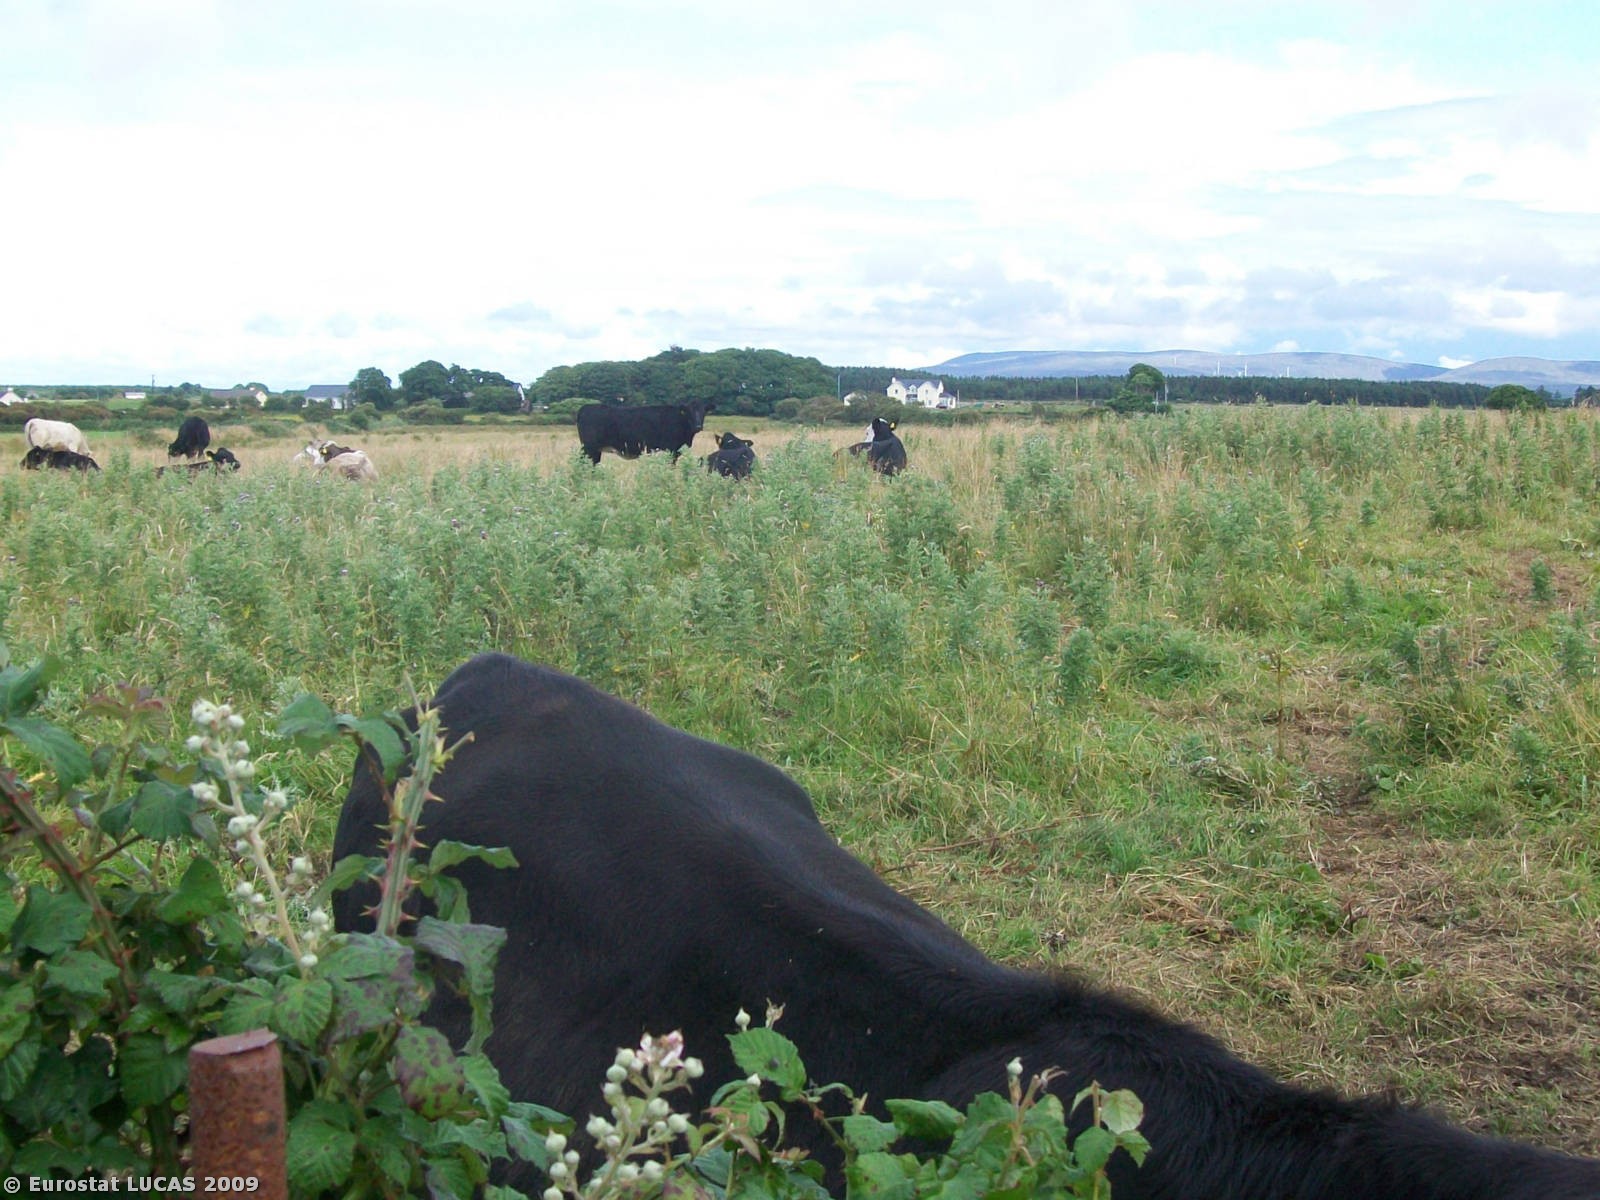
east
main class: Grassland
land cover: Grassland without tree/shrub cover
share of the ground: > 75 %
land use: Agriculture (excluding fallow land and kitchen gardens)
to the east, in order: Grassland without tree/shrub cover
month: July
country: IE
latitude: 54.2495
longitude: -8.9804
